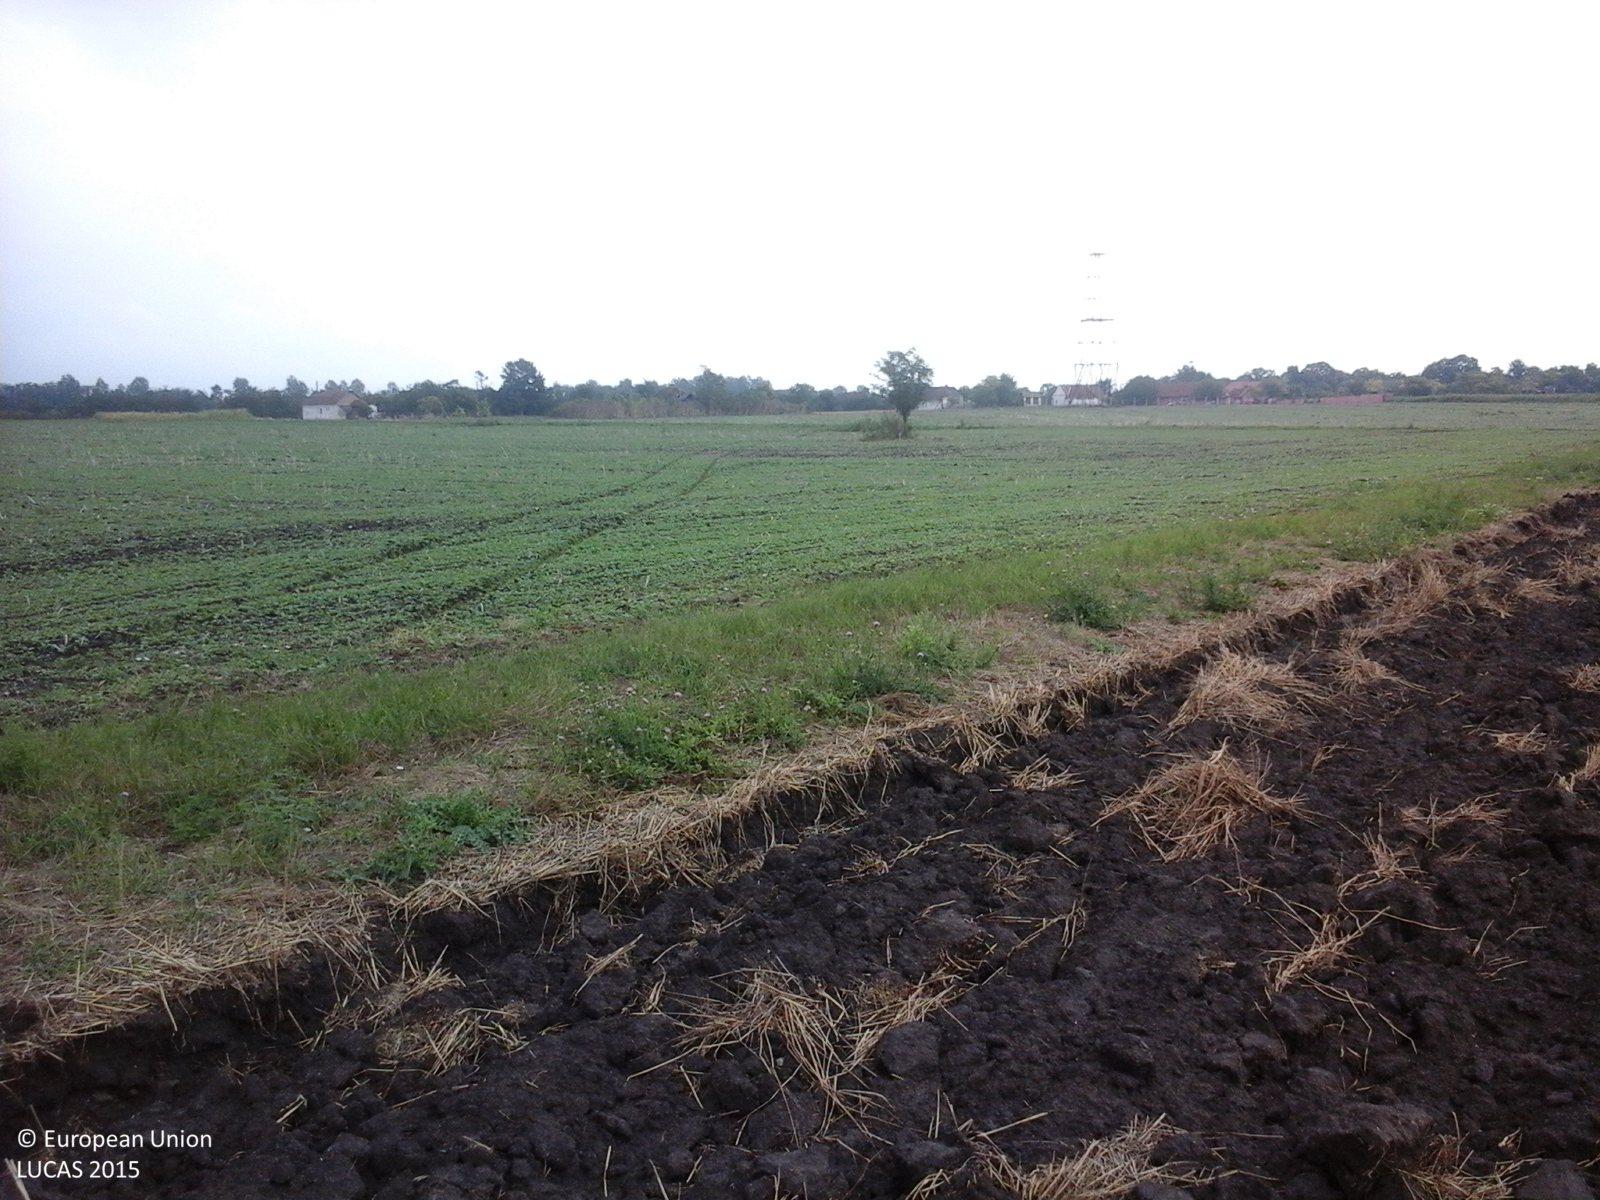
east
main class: Cropland
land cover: Common wheat
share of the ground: < 10 %
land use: Agriculture (excluding fallow land and kitchen gardens)
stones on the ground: < 10 %
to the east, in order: Common wheat; Grass margins; Rape and turnip rape; Grass margins; Tracks; Grass margins; Rape and turnip rape
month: August
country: RO
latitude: 46.1520
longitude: 20.3951
